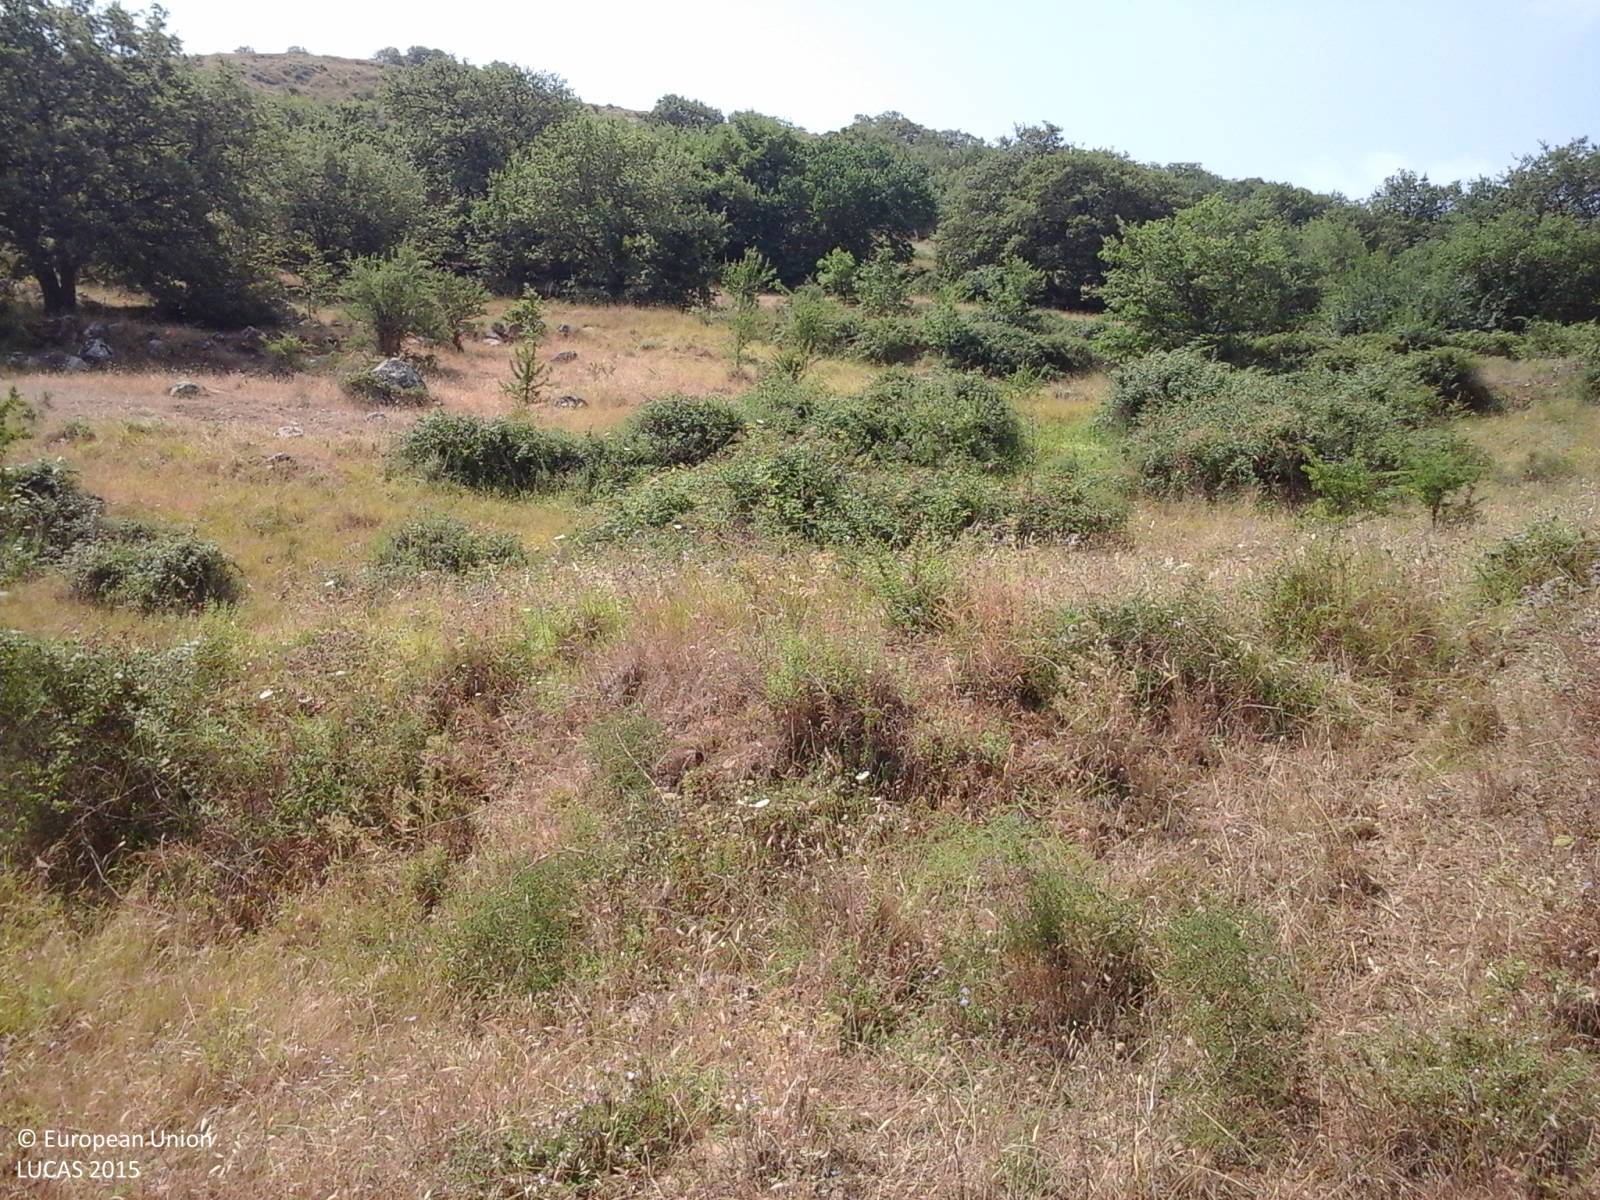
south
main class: Grassland
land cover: Grassland without tree/shrub cover
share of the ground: 25 - 50 %
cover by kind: herbaceous plants 100 %
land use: Agriculture (excluding fallow land and kitchen gardens)
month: July
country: IT
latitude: 40.4231
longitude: 8.8156
